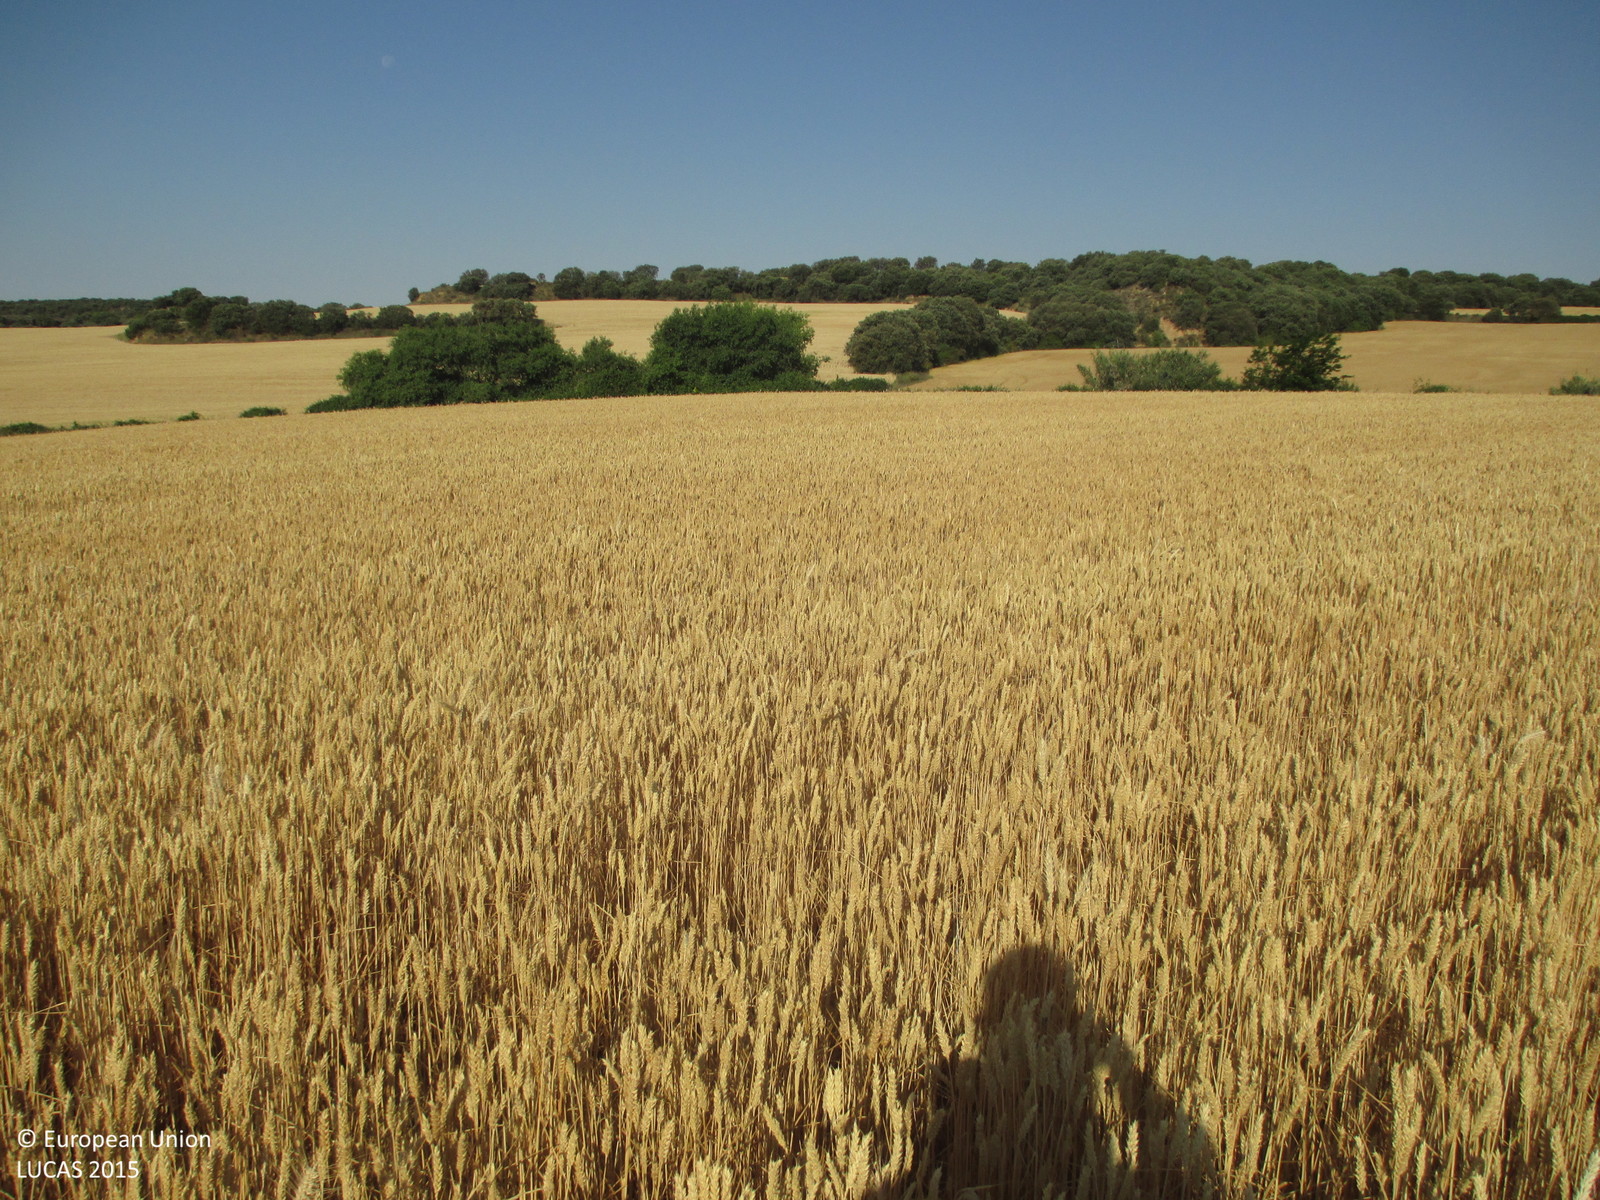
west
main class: Cropland
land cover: Common wheat
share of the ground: > 75 %
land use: Agriculture (excluding fallow land and kitchen gardens)
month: June
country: ES
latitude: 42.1512
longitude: -0.2473
